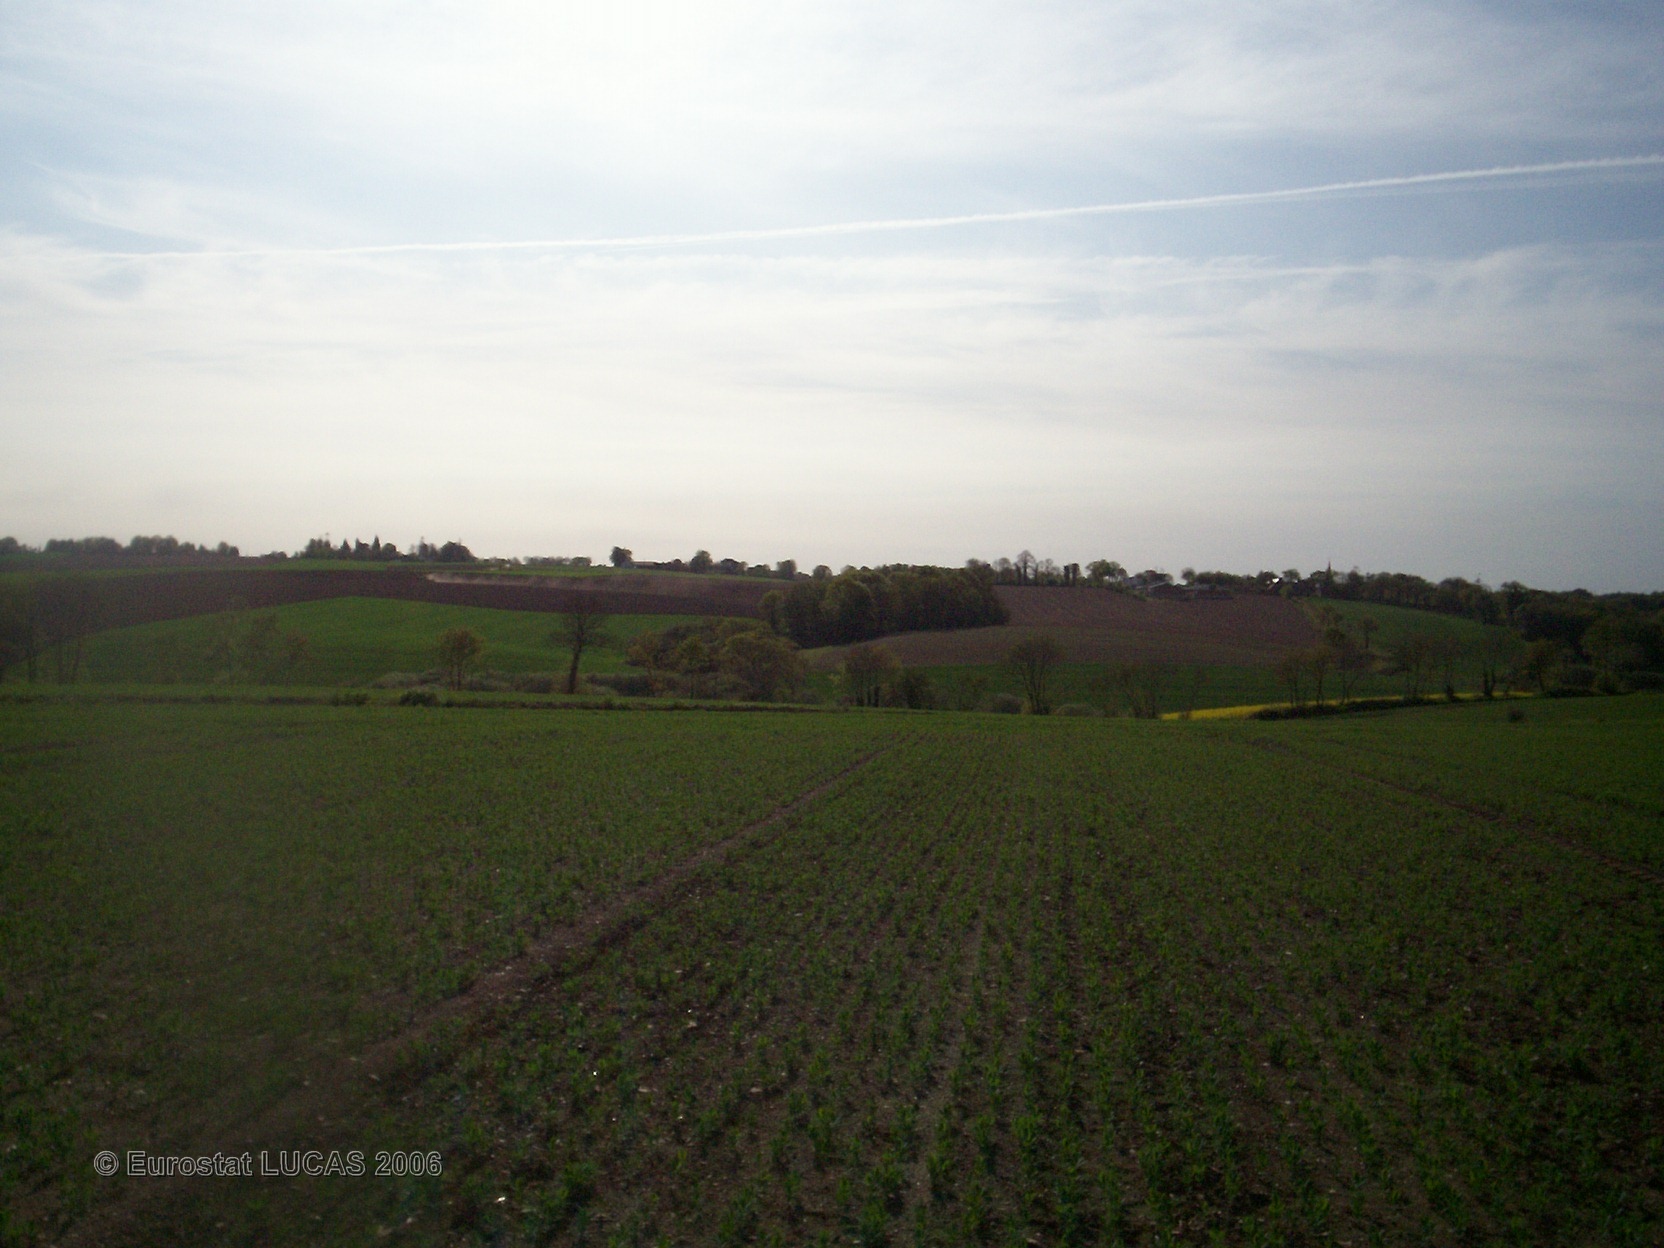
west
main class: Cropland
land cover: Dry pulses
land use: Agriculture (excluding fallow land and kitchen gardens)
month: May
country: FR
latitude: 47.9706
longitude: -2.9119
